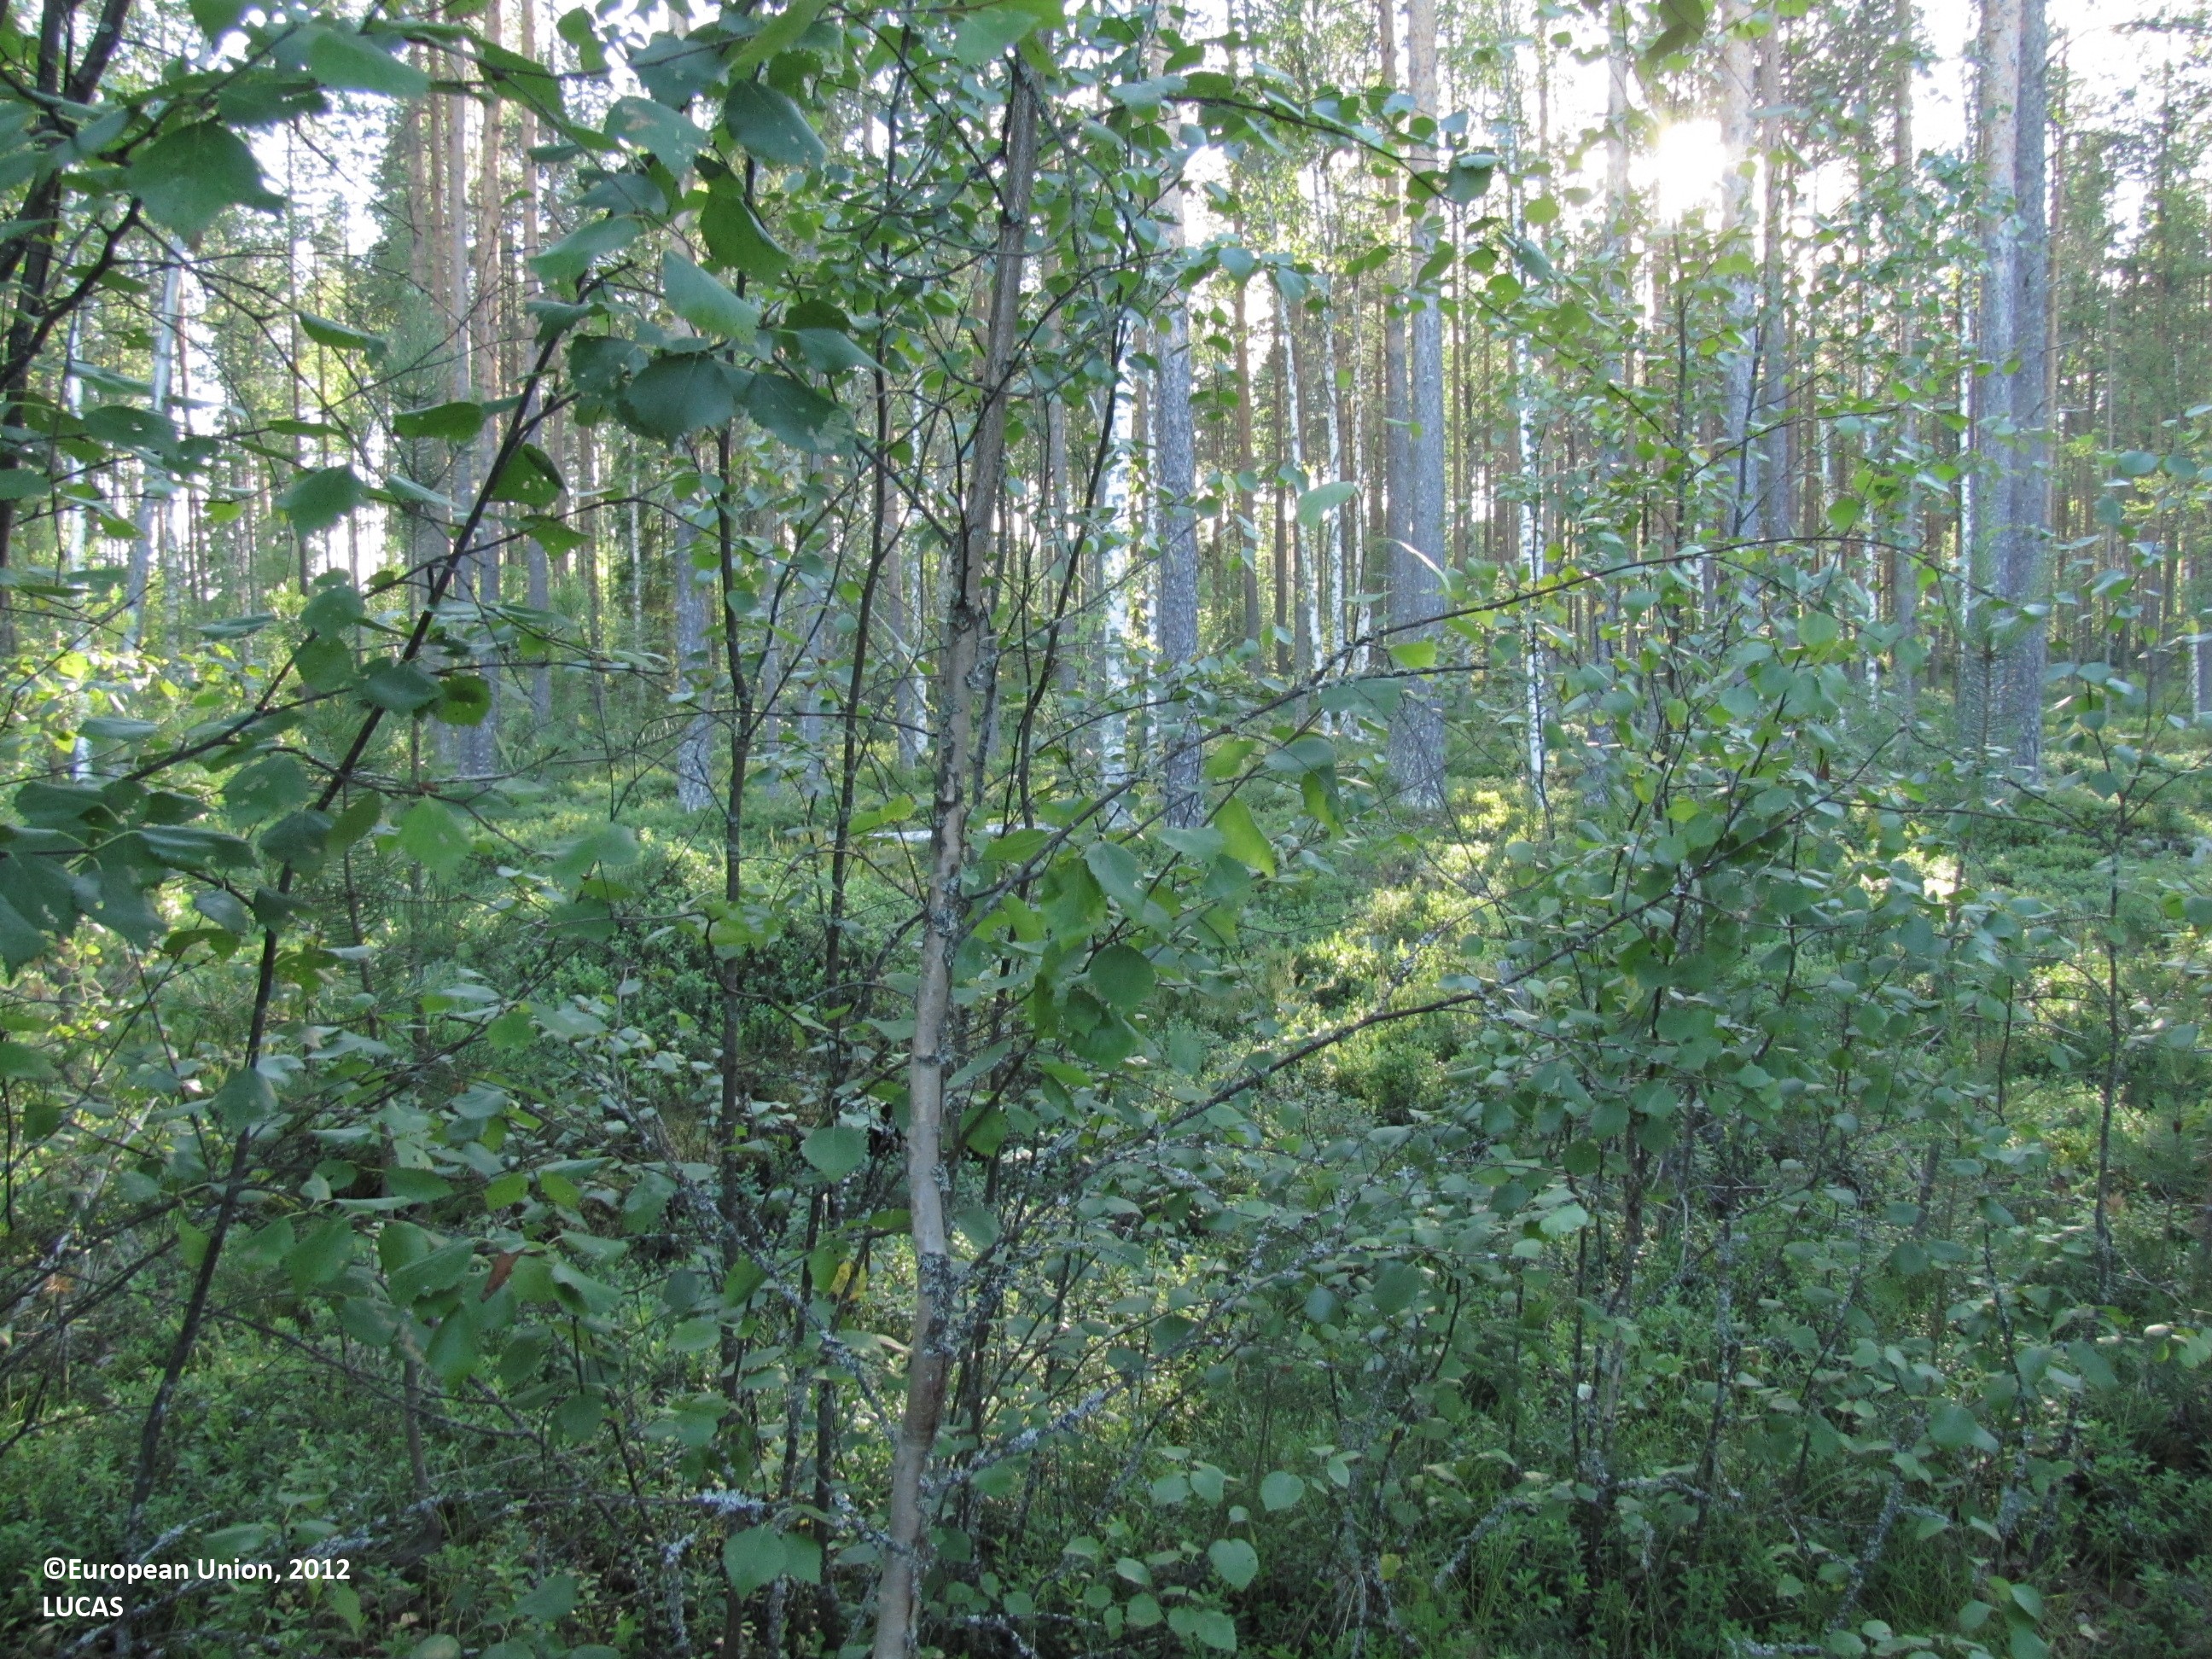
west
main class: Woodland
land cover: Broadleaved woodland
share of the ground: 25 - 50 %
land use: Forestry
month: July
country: FI
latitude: 62.5104
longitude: 23.1342
